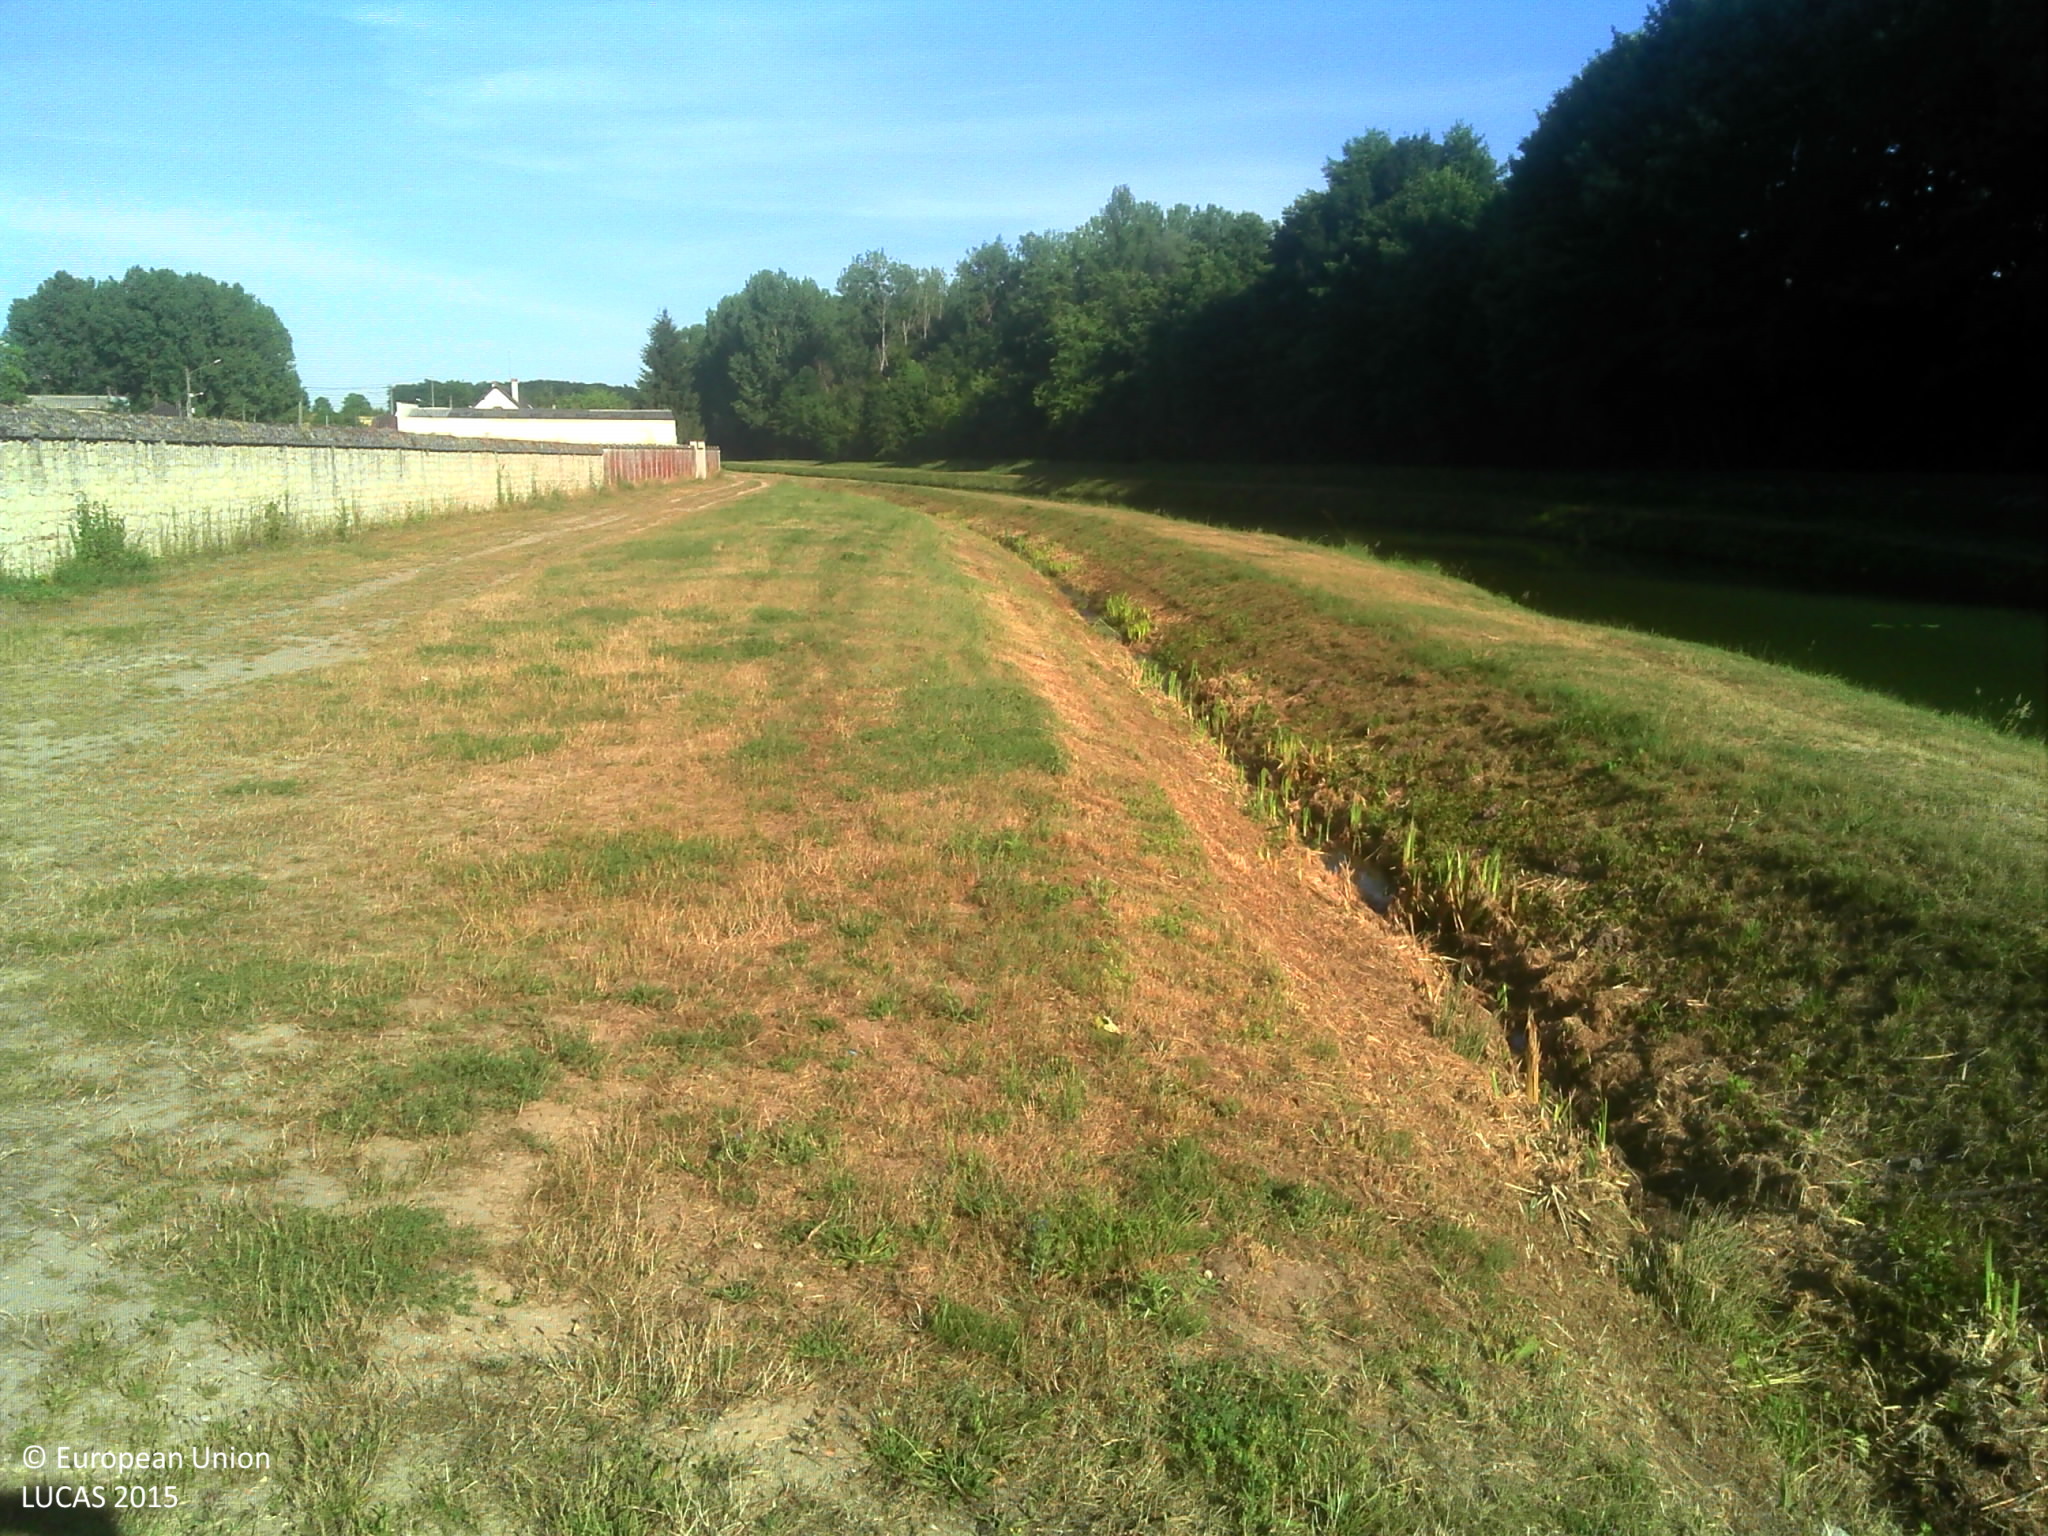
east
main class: Grassland
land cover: Grassland without tree/shrub cover
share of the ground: > 75 %
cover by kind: herbaceous plants 100 %
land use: Amenities, museums, leisure
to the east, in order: Grassland without tree/shrub cover; Tracks; Grass margins; Dry stone walls; Artificial constructions in urban areas; Grassland with sparse tree/shrub cover; Artificial constructions in urban areas
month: June
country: FR
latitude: 47.2723
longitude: 1.4076
